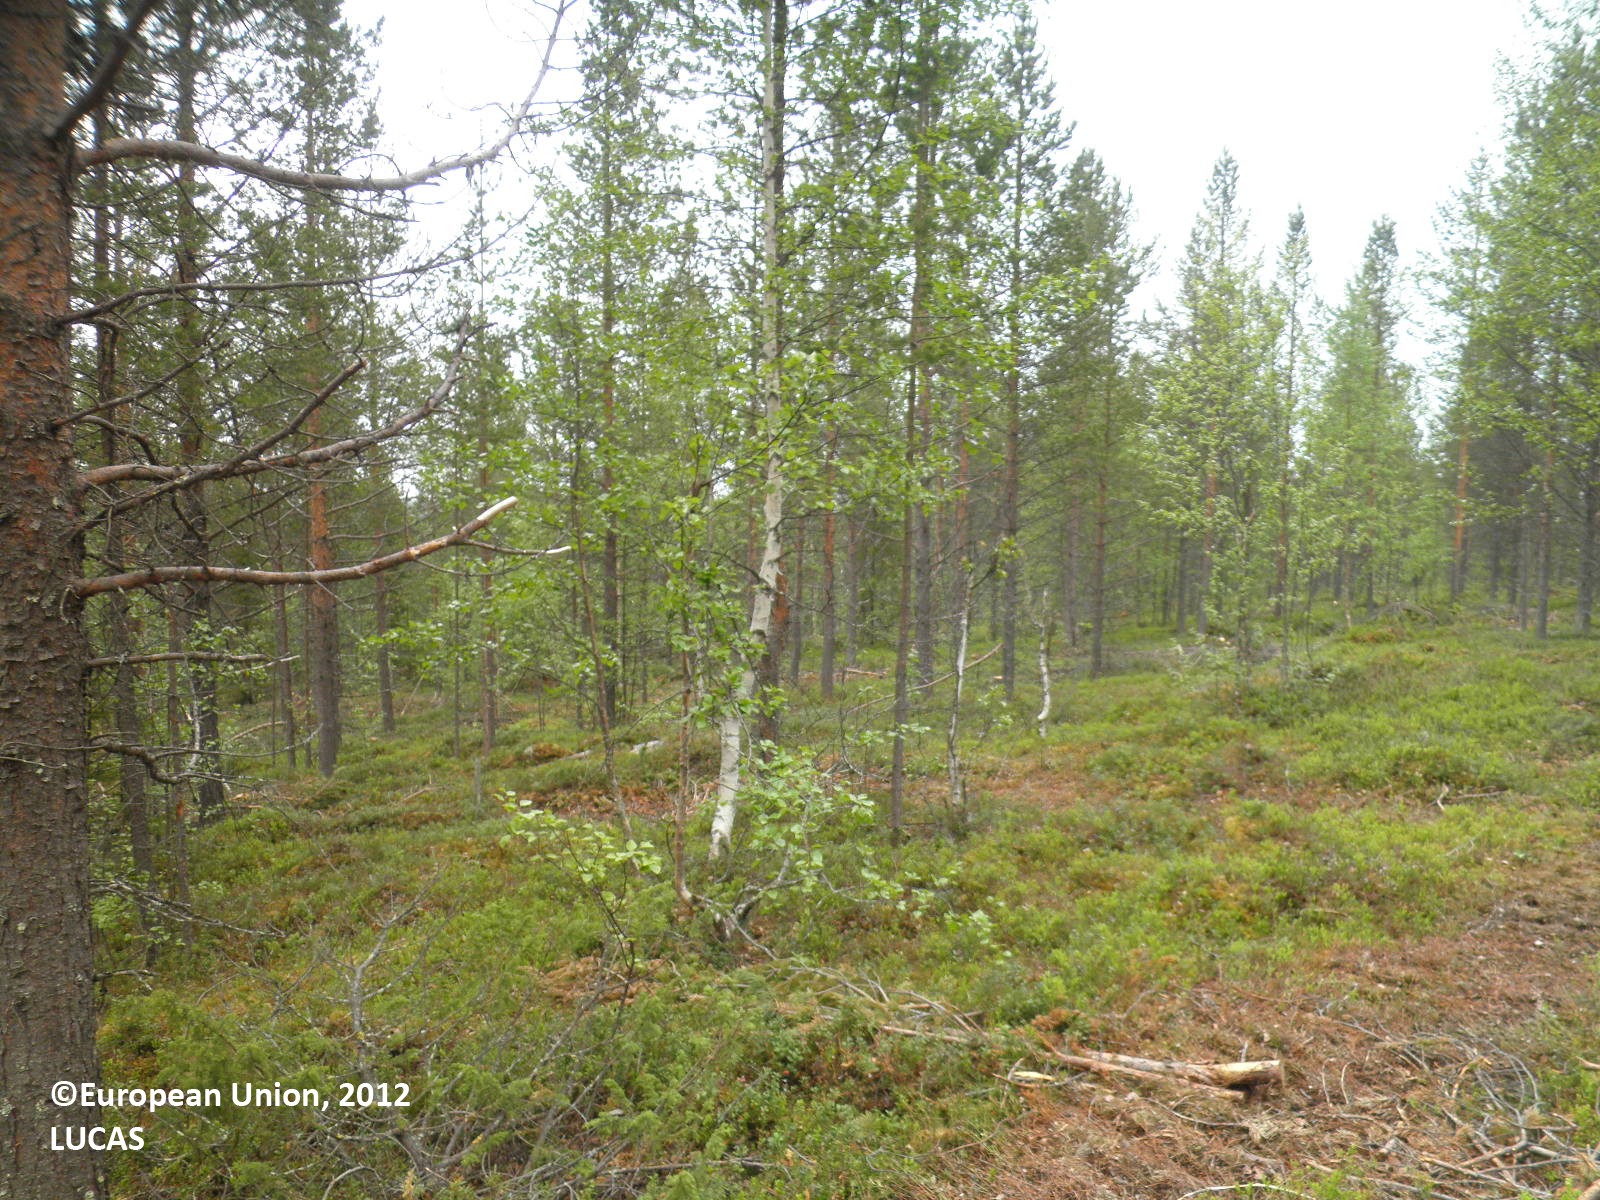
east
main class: Woodland
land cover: Pine dominated coniferous woodland
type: boreal forest
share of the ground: 25 - 50 %
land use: Forestry
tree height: > 5 m
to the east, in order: Tracks; Pine dominated coniferous woodland; Pine dominated mixed woodland; Ditches and canals; Pine dominated mixed woodland; Ditches and canals; Pine dominated mixed woodland; Ditches and canals; Pine dominated mixed woodland; Ditches and canals; Pine dominated mixed woodland; Ditches and canals; Pine dominated mixed woodland; Ditches and canals; Pine dominated mixed woodland; Ditches and canals; Pine dominated mixed woodland; Ditches and canals; Pine dominated mixed woodland; Ditches and canals; Pine dominated mixed woodland
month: June
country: FI
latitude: 67.8137
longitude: 25.5408
